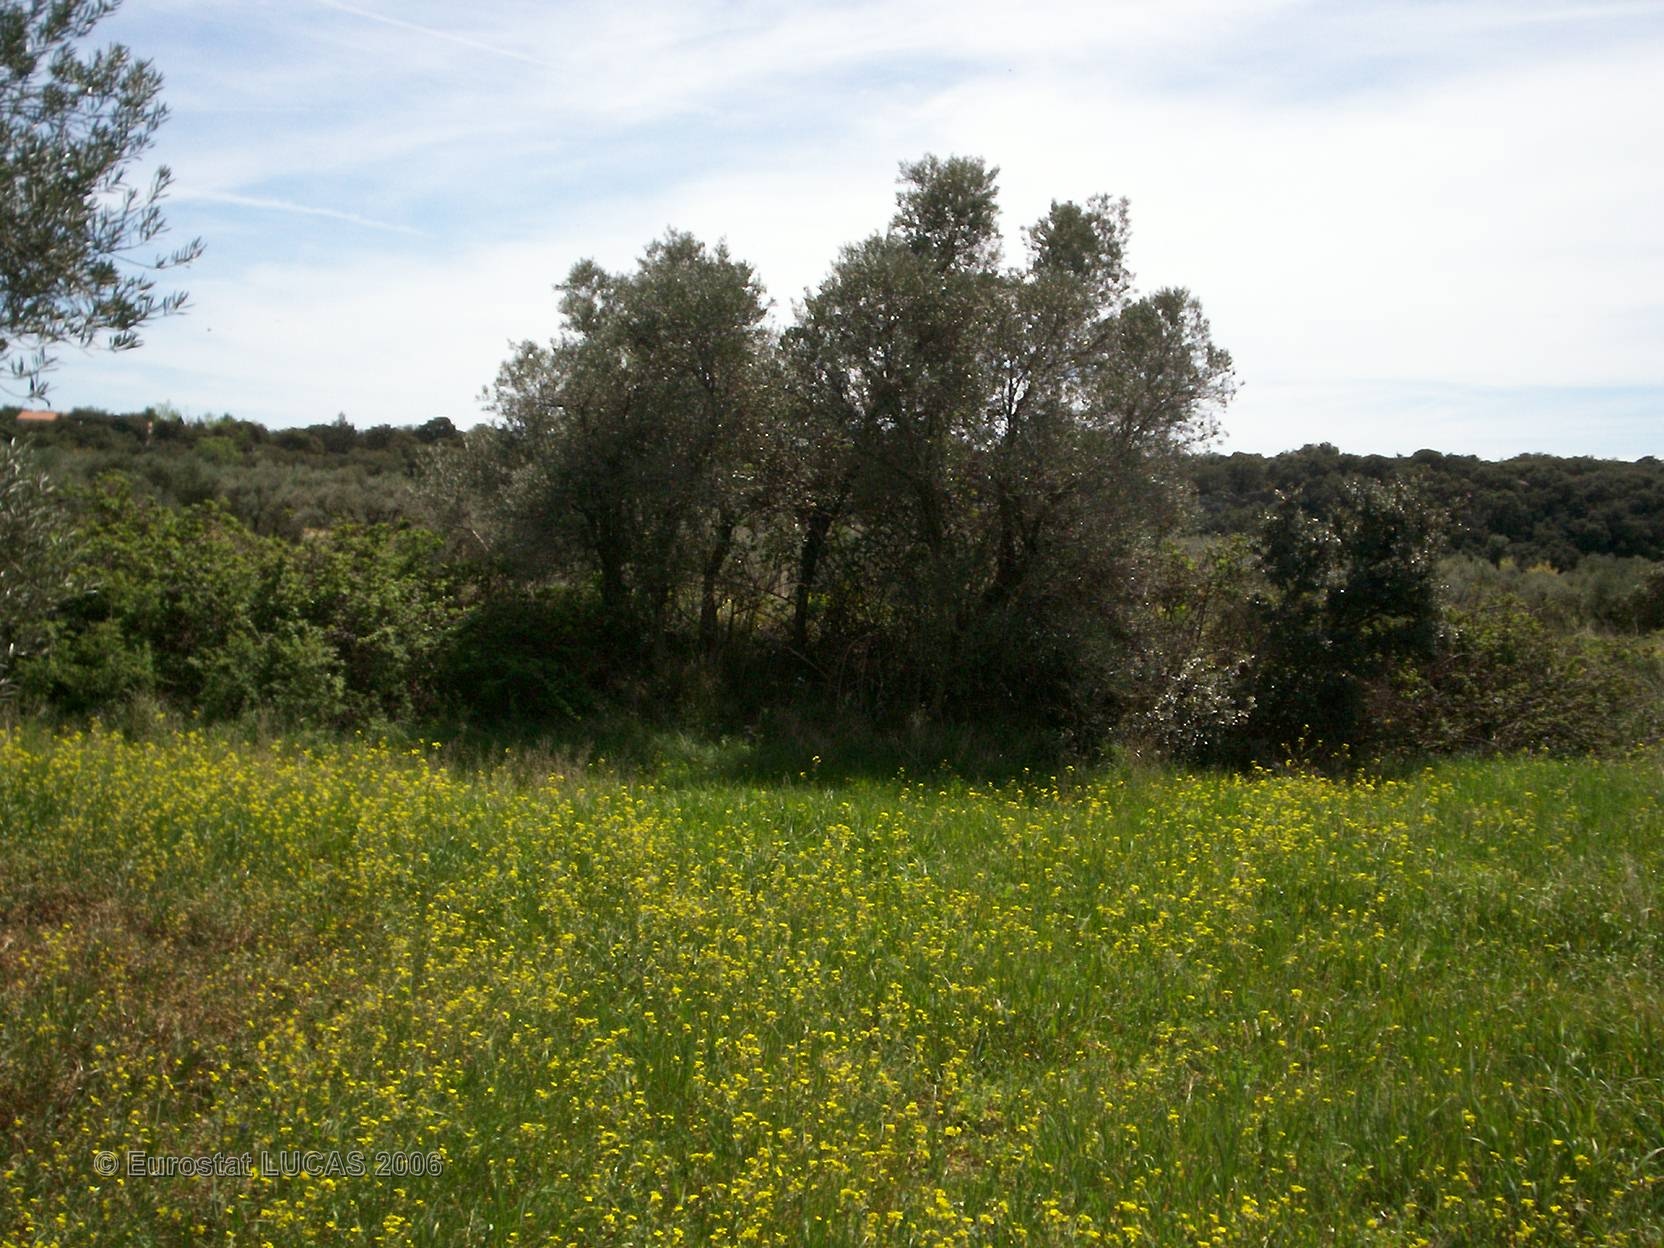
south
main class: Cropland
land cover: Olive groves
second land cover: Grassland with sparse tree/shrub cover
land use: Agriculture (excluding fallow land and kitchen gardens)
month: April
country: FR
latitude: 43.7027
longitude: 4.9340
